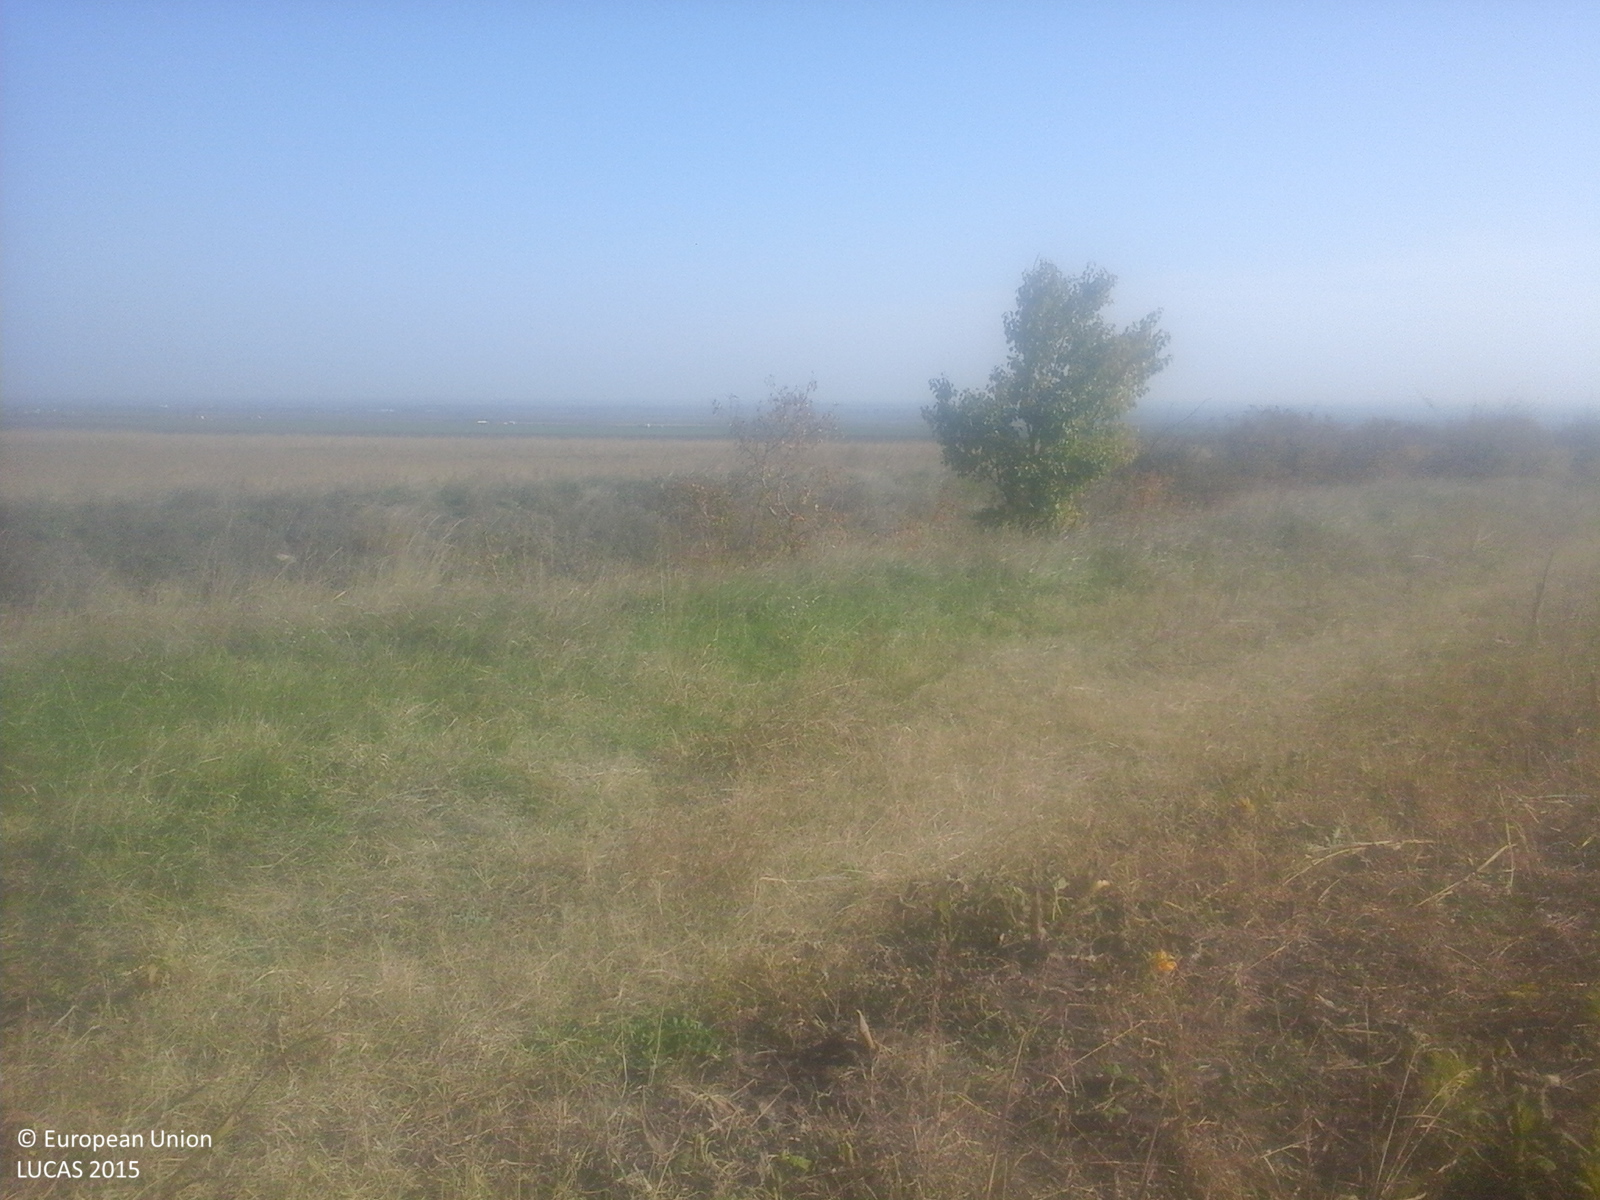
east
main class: Cropland
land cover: Maize
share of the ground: 10 - 25 %
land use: Agriculture (excluding fallow land and kitchen gardens)
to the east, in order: Maize; Grass margins; Ditches and canals; Grass margins; Tracks; Common wheat; Maize; Other bare soil; Maize; Common wheat
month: October
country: RO
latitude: 45.3499
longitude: 26.9723
